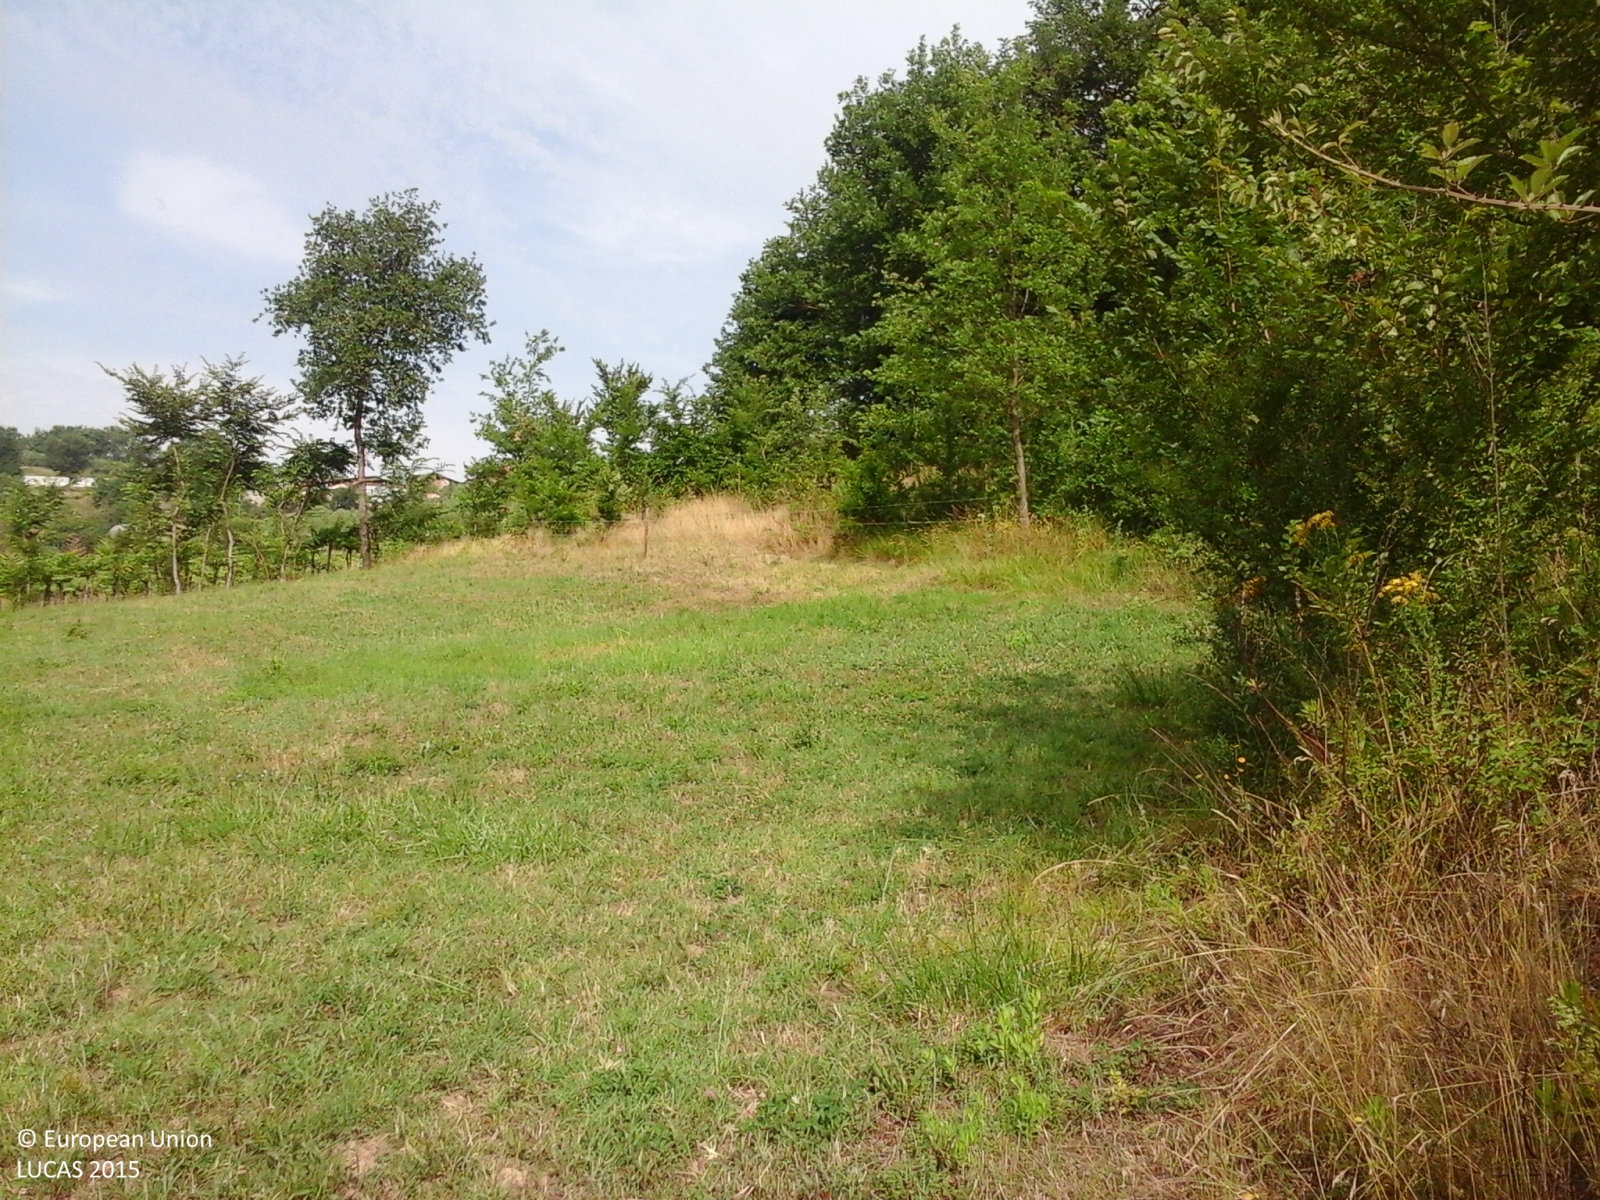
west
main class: Grassland
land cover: Grassland without tree/shrub cover
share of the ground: > 75 %
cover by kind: herbaceous plants 100 %
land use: Agriculture (excluding fallow land and kitchen gardens)
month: June
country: IT
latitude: 41.5841
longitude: 13.4056
